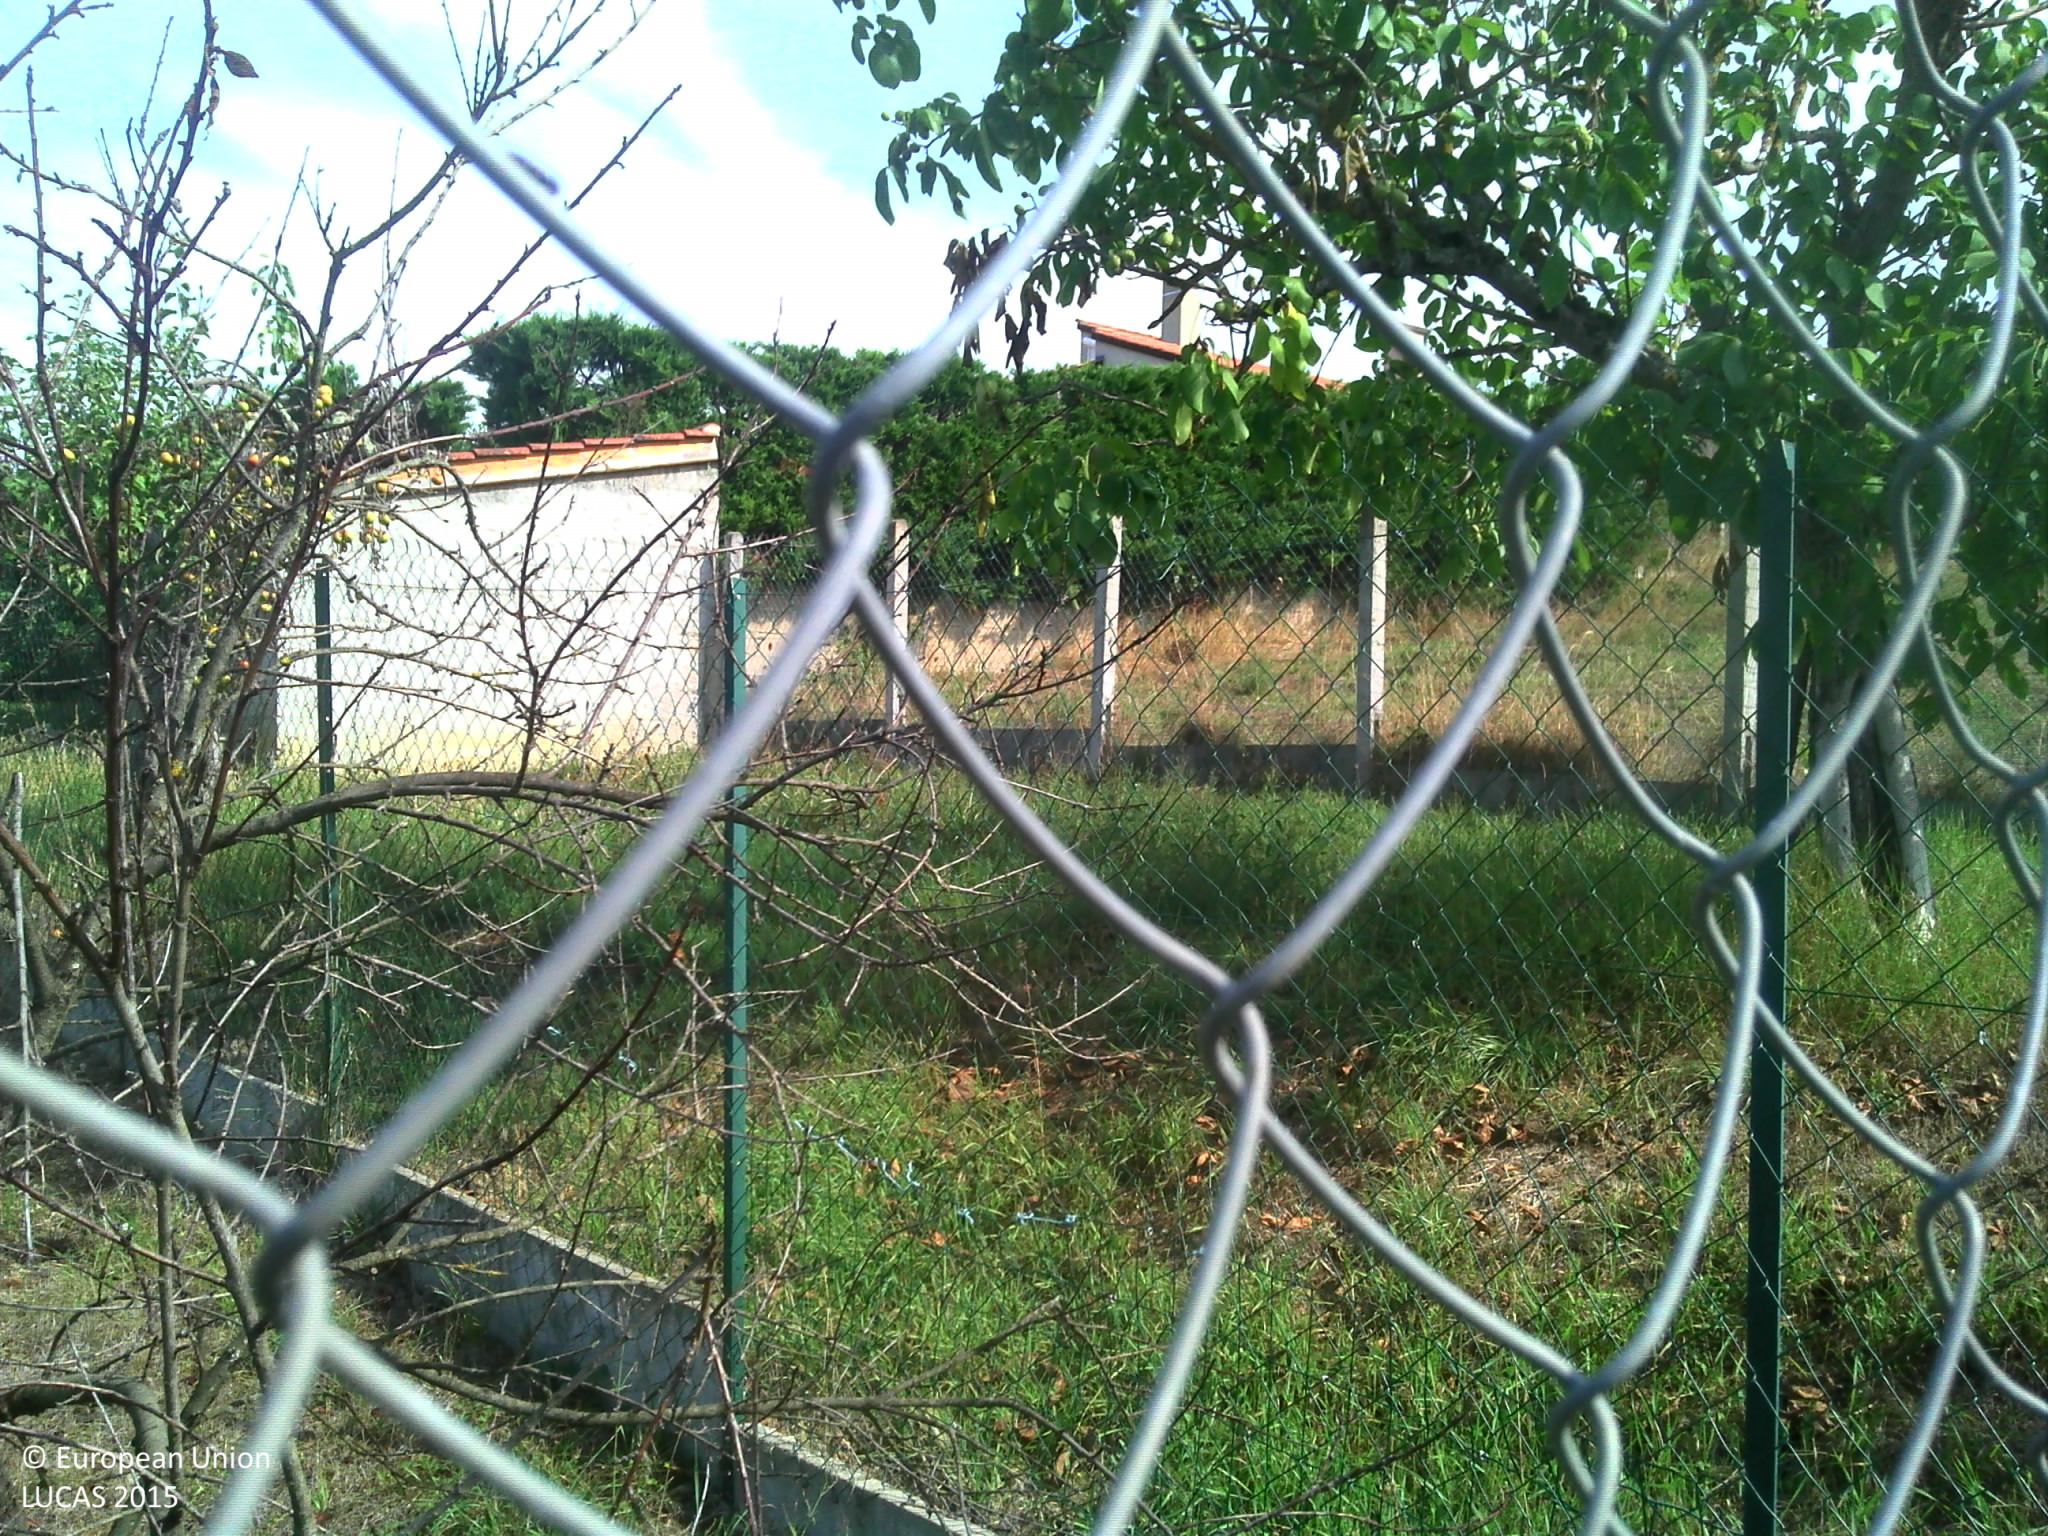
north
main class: Grassland
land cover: Grassland with sparse tree/shrub cover
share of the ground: > 75 %
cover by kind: herbaceous plants 85 %, shrubs 10 %, broadleaved forest trees 5 %
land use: Residential
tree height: > 5 m
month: August
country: FR
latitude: 44.8657
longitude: 1.8857
